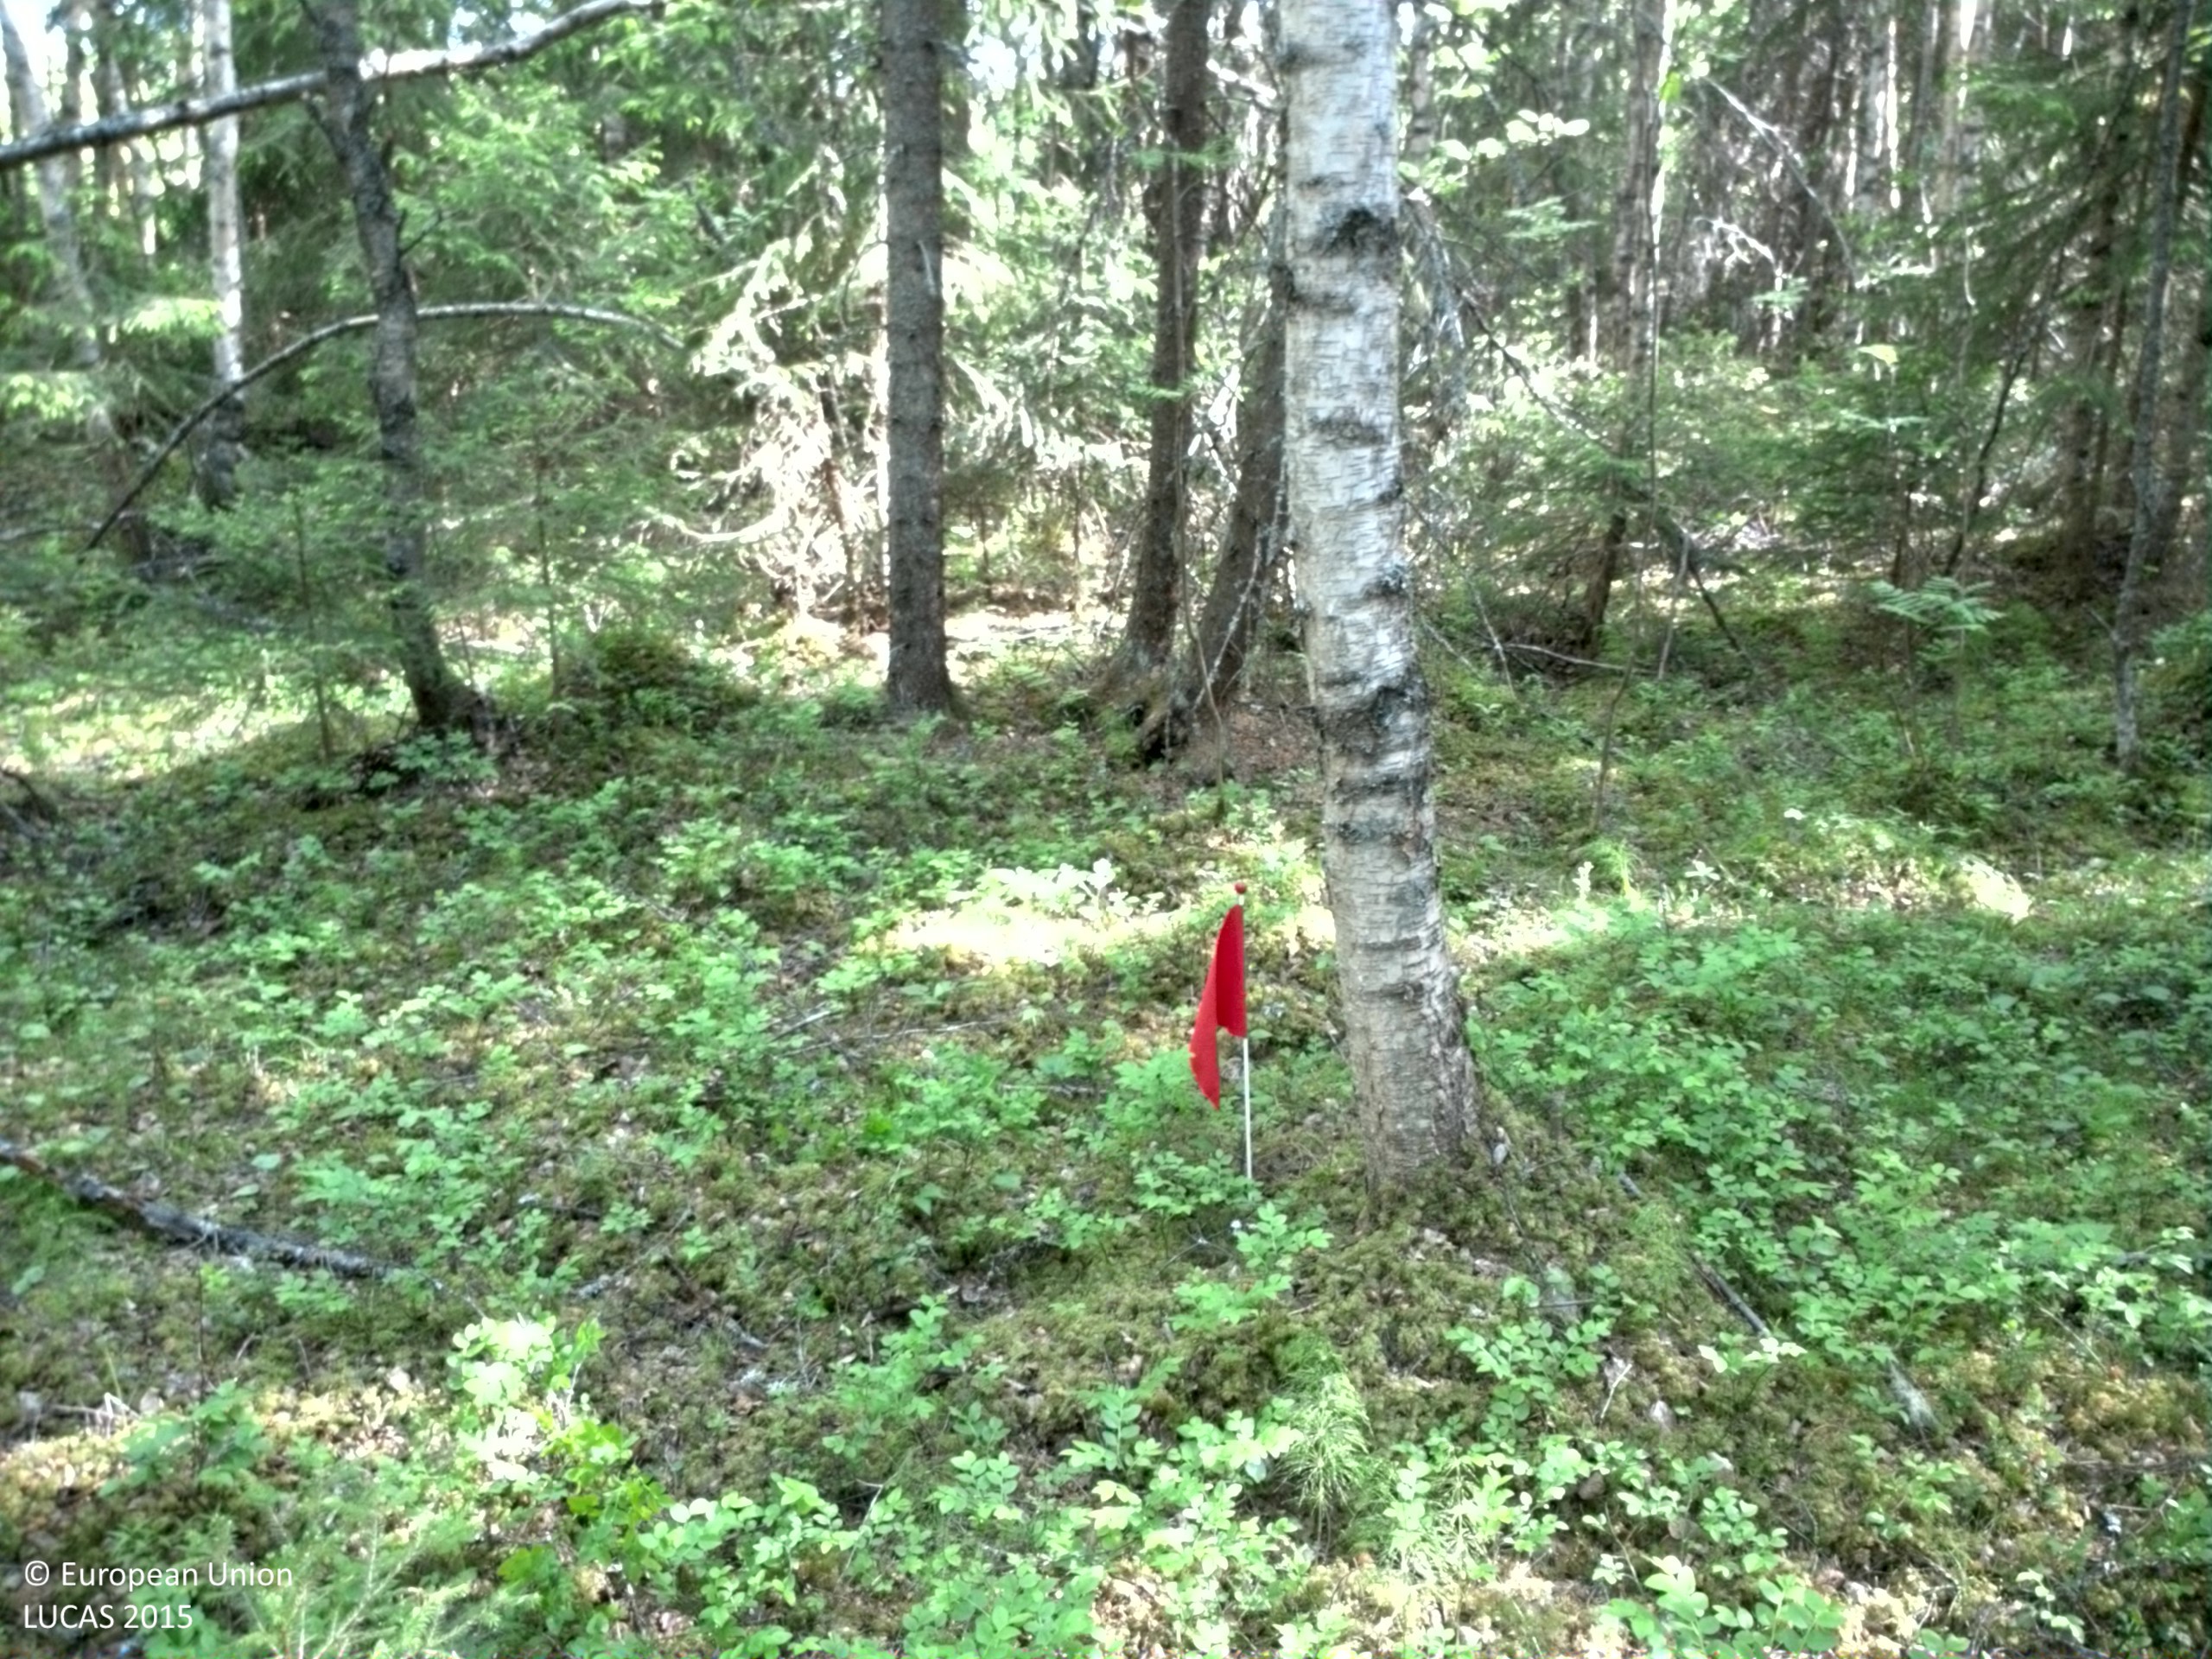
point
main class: Woodland
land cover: Broadleaved woodland
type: boreal forest
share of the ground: 50 - 75 %
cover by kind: broadleaved forest trees 60 %, herbaceous plants 20 %, shrubs 15 %, coniferous forest trees 5 %
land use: Forestry
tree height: > 5 m
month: June
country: SE
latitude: 63.1388
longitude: 17.7333
